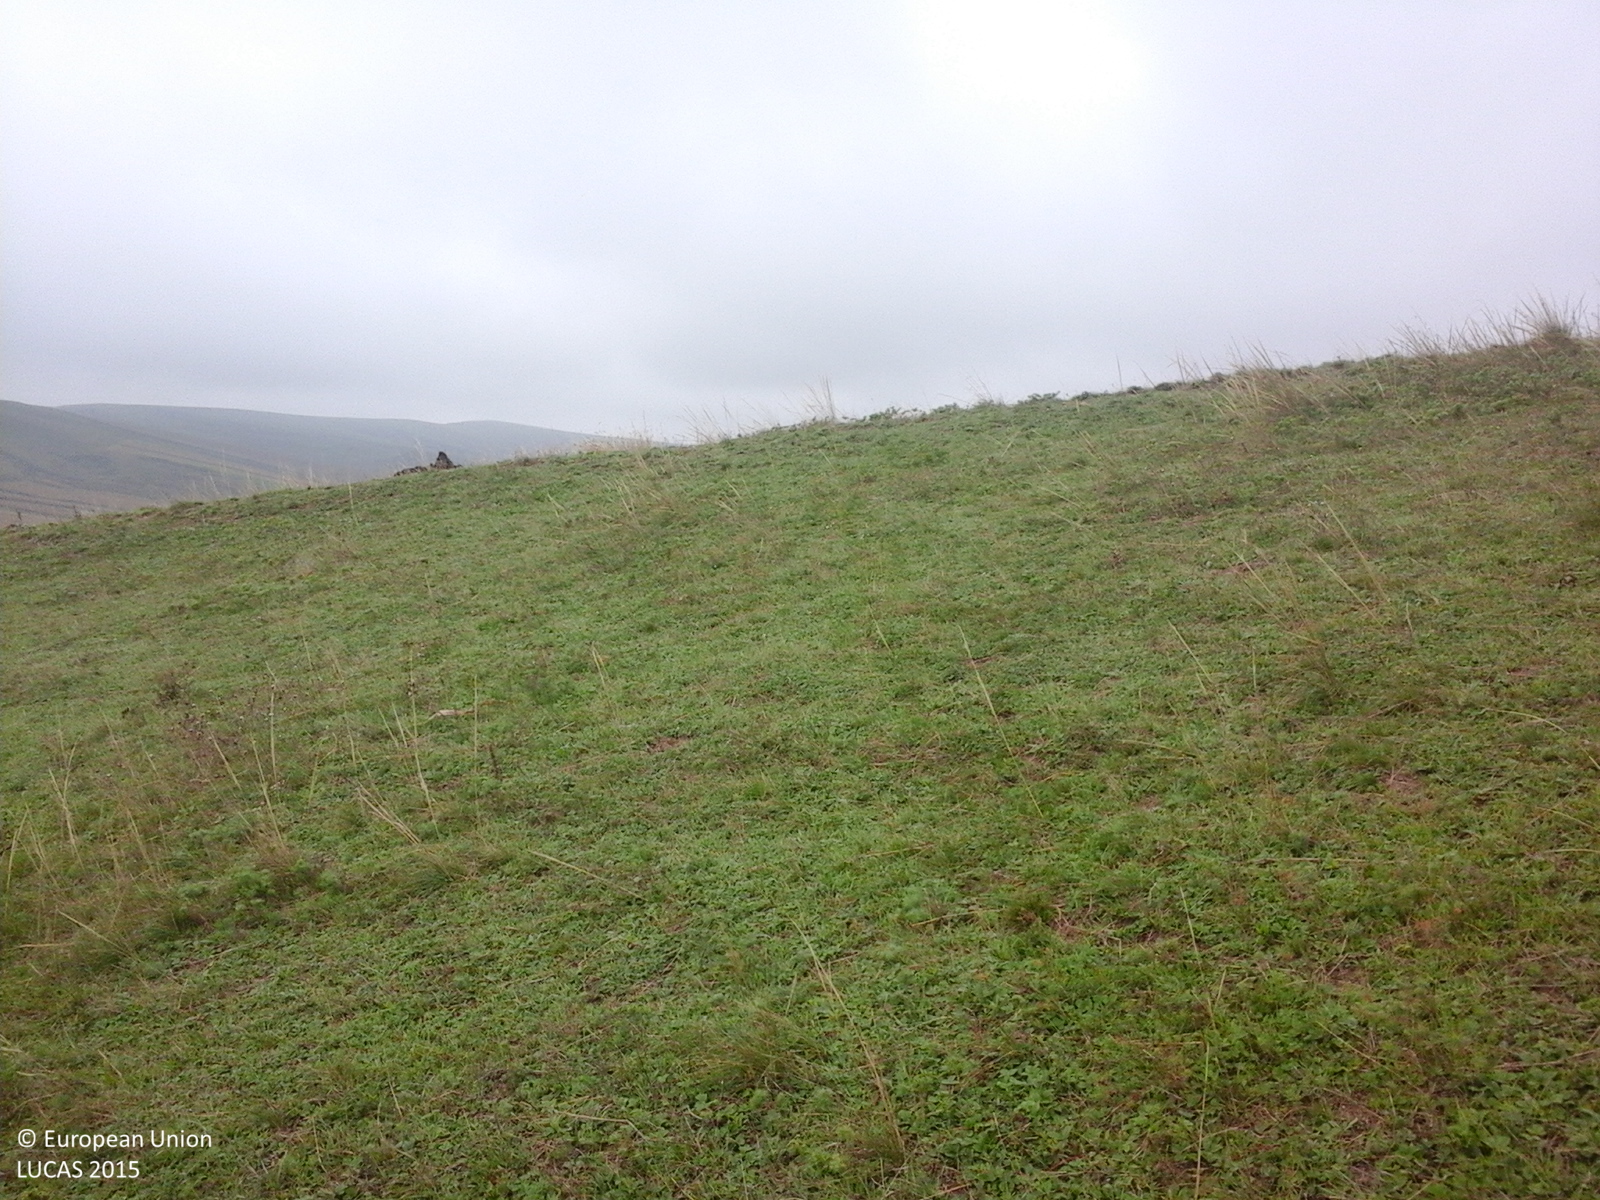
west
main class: Grassland
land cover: Grassland without tree/shrub cover
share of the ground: > 75 %
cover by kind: herbaceous plants 100 %
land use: Agriculture (excluding fallow land and kitchen gardens)
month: October
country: RO
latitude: 46.6246
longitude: 23.9066
